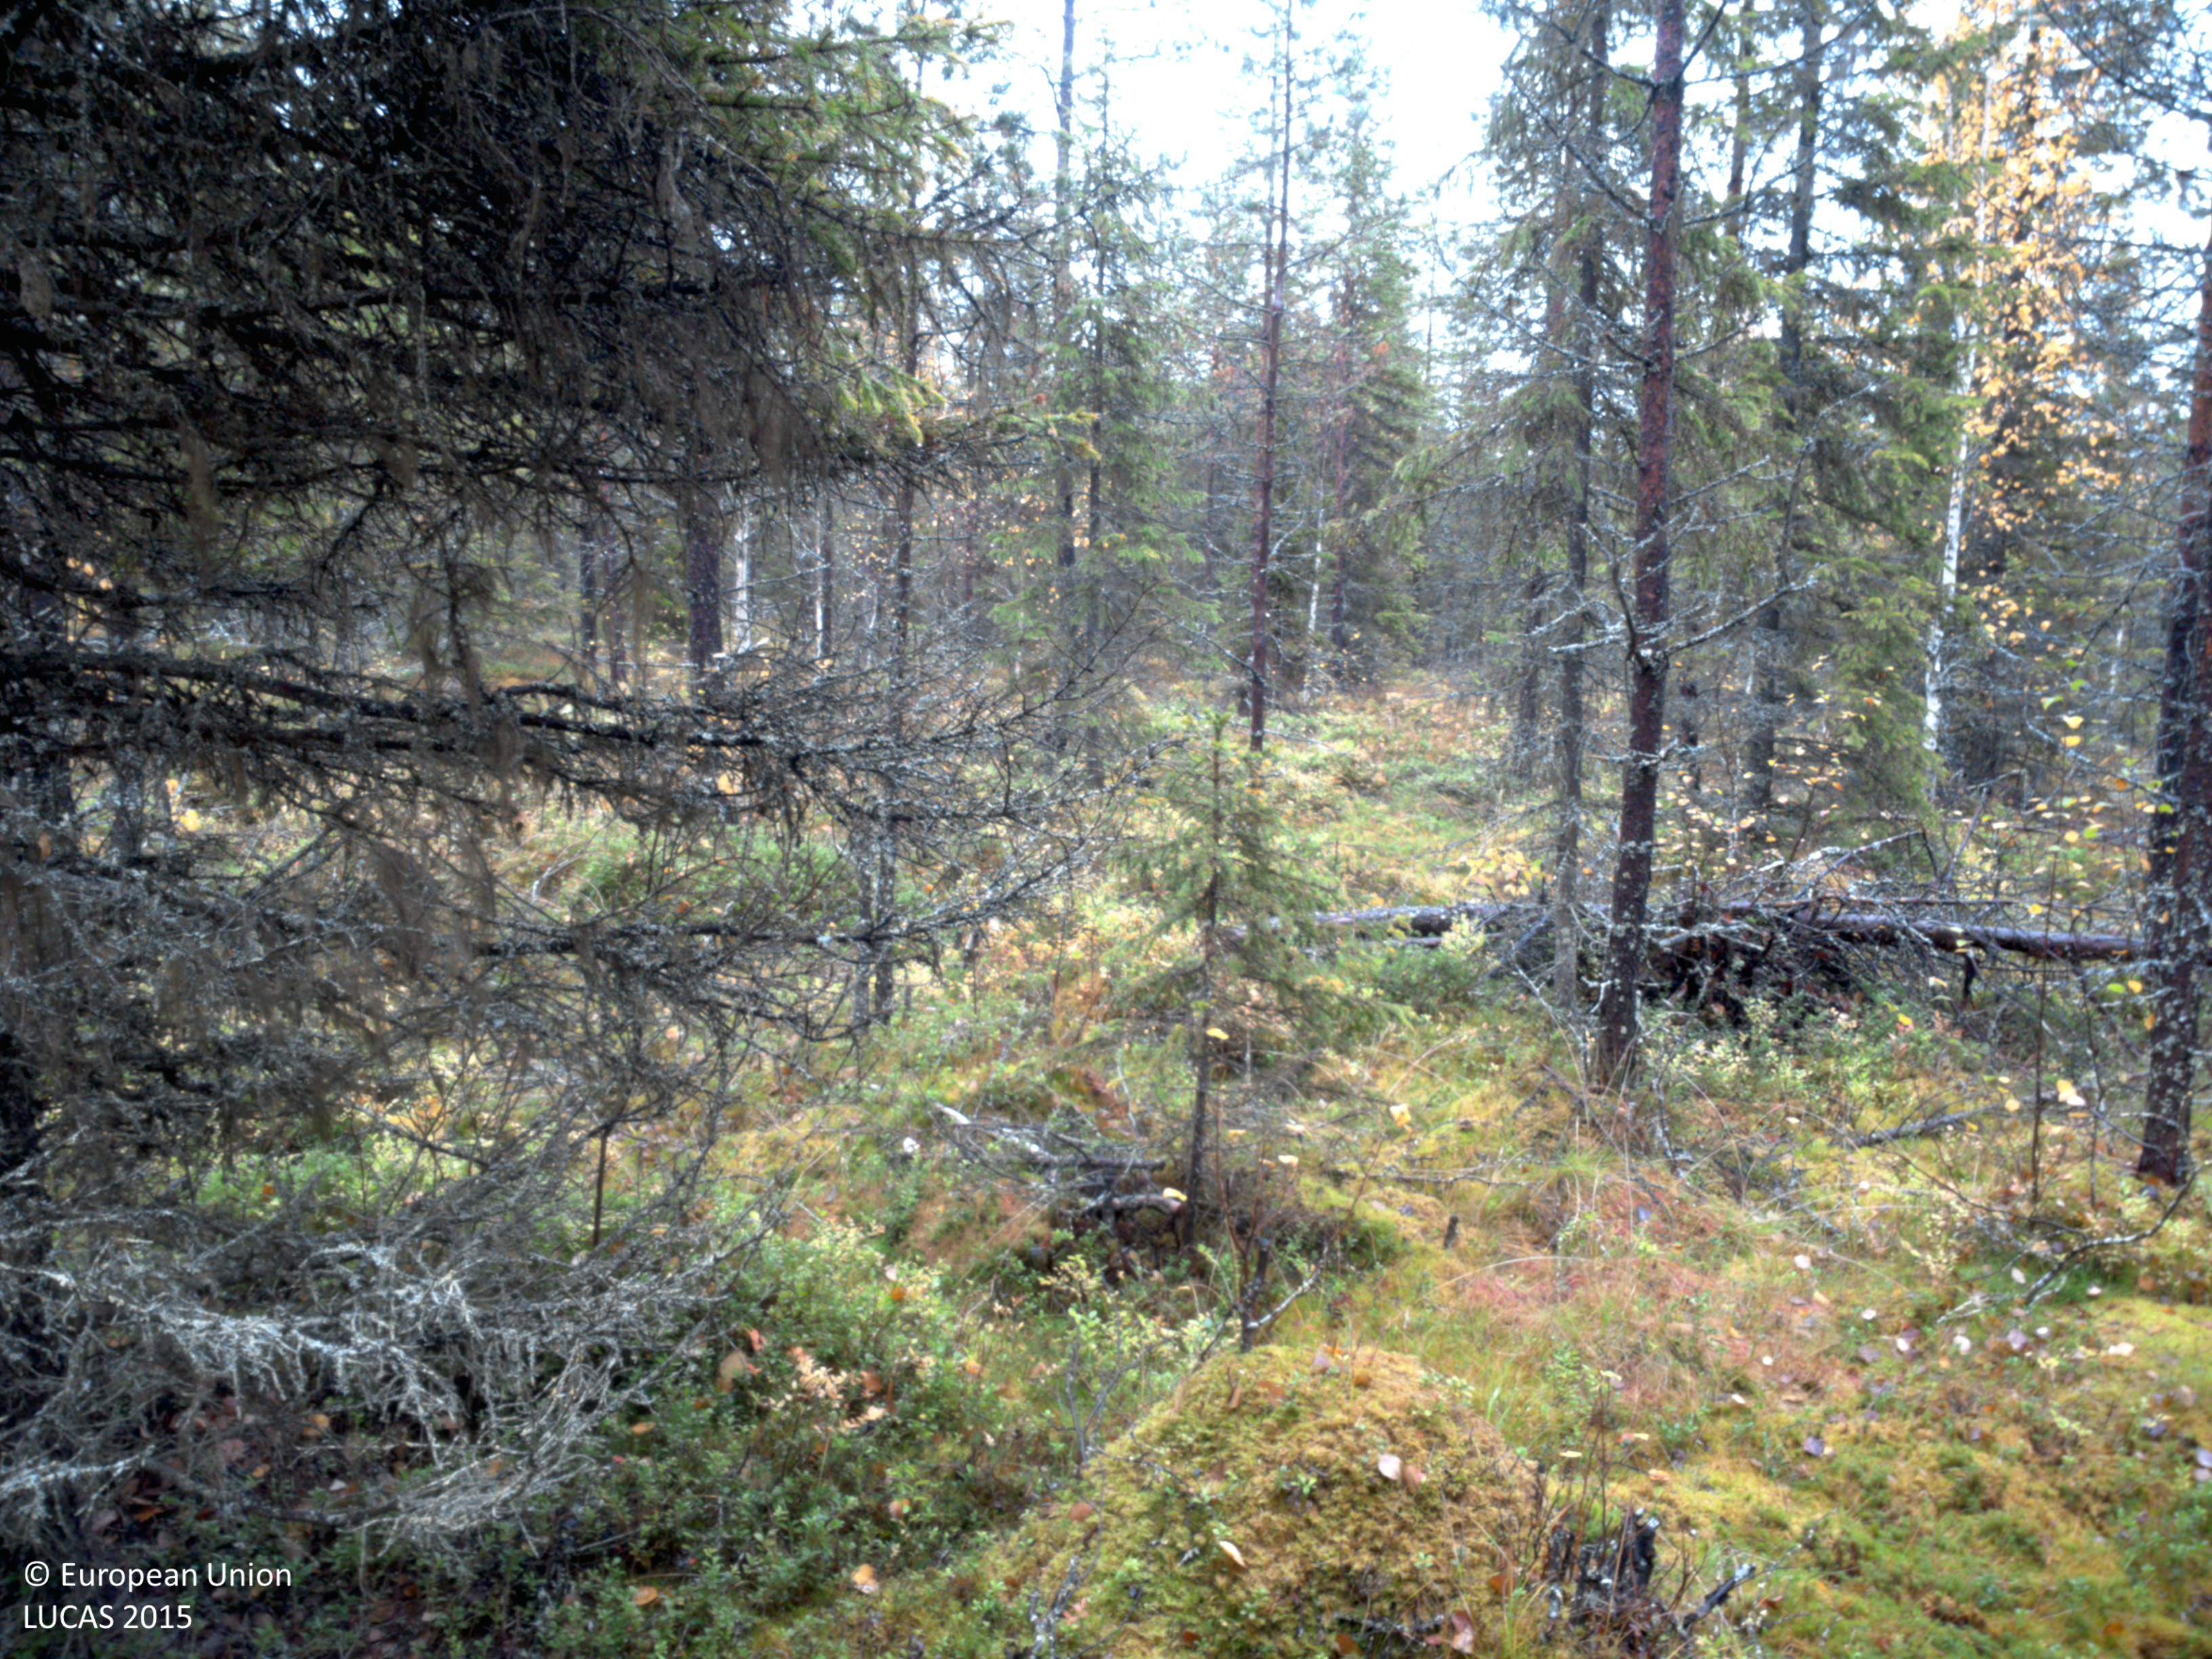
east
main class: Woodland
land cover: Spruce dominated mixed woodland
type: boreal forest
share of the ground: > 75 %
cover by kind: coniferous forest trees 55 %, broadleaved forest trees 25 %, shrubs 10 %, herbaceous plants 5 %, lichens and mosses 5 %
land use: Forestry
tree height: > 5 m
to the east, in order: Spruce dominated mixed woodland; Spruce dominated coniferous woodland; Ditches and canals; Spruce dominated coniferous woodland
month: September
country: SE
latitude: 64.9967
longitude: 19.0196
